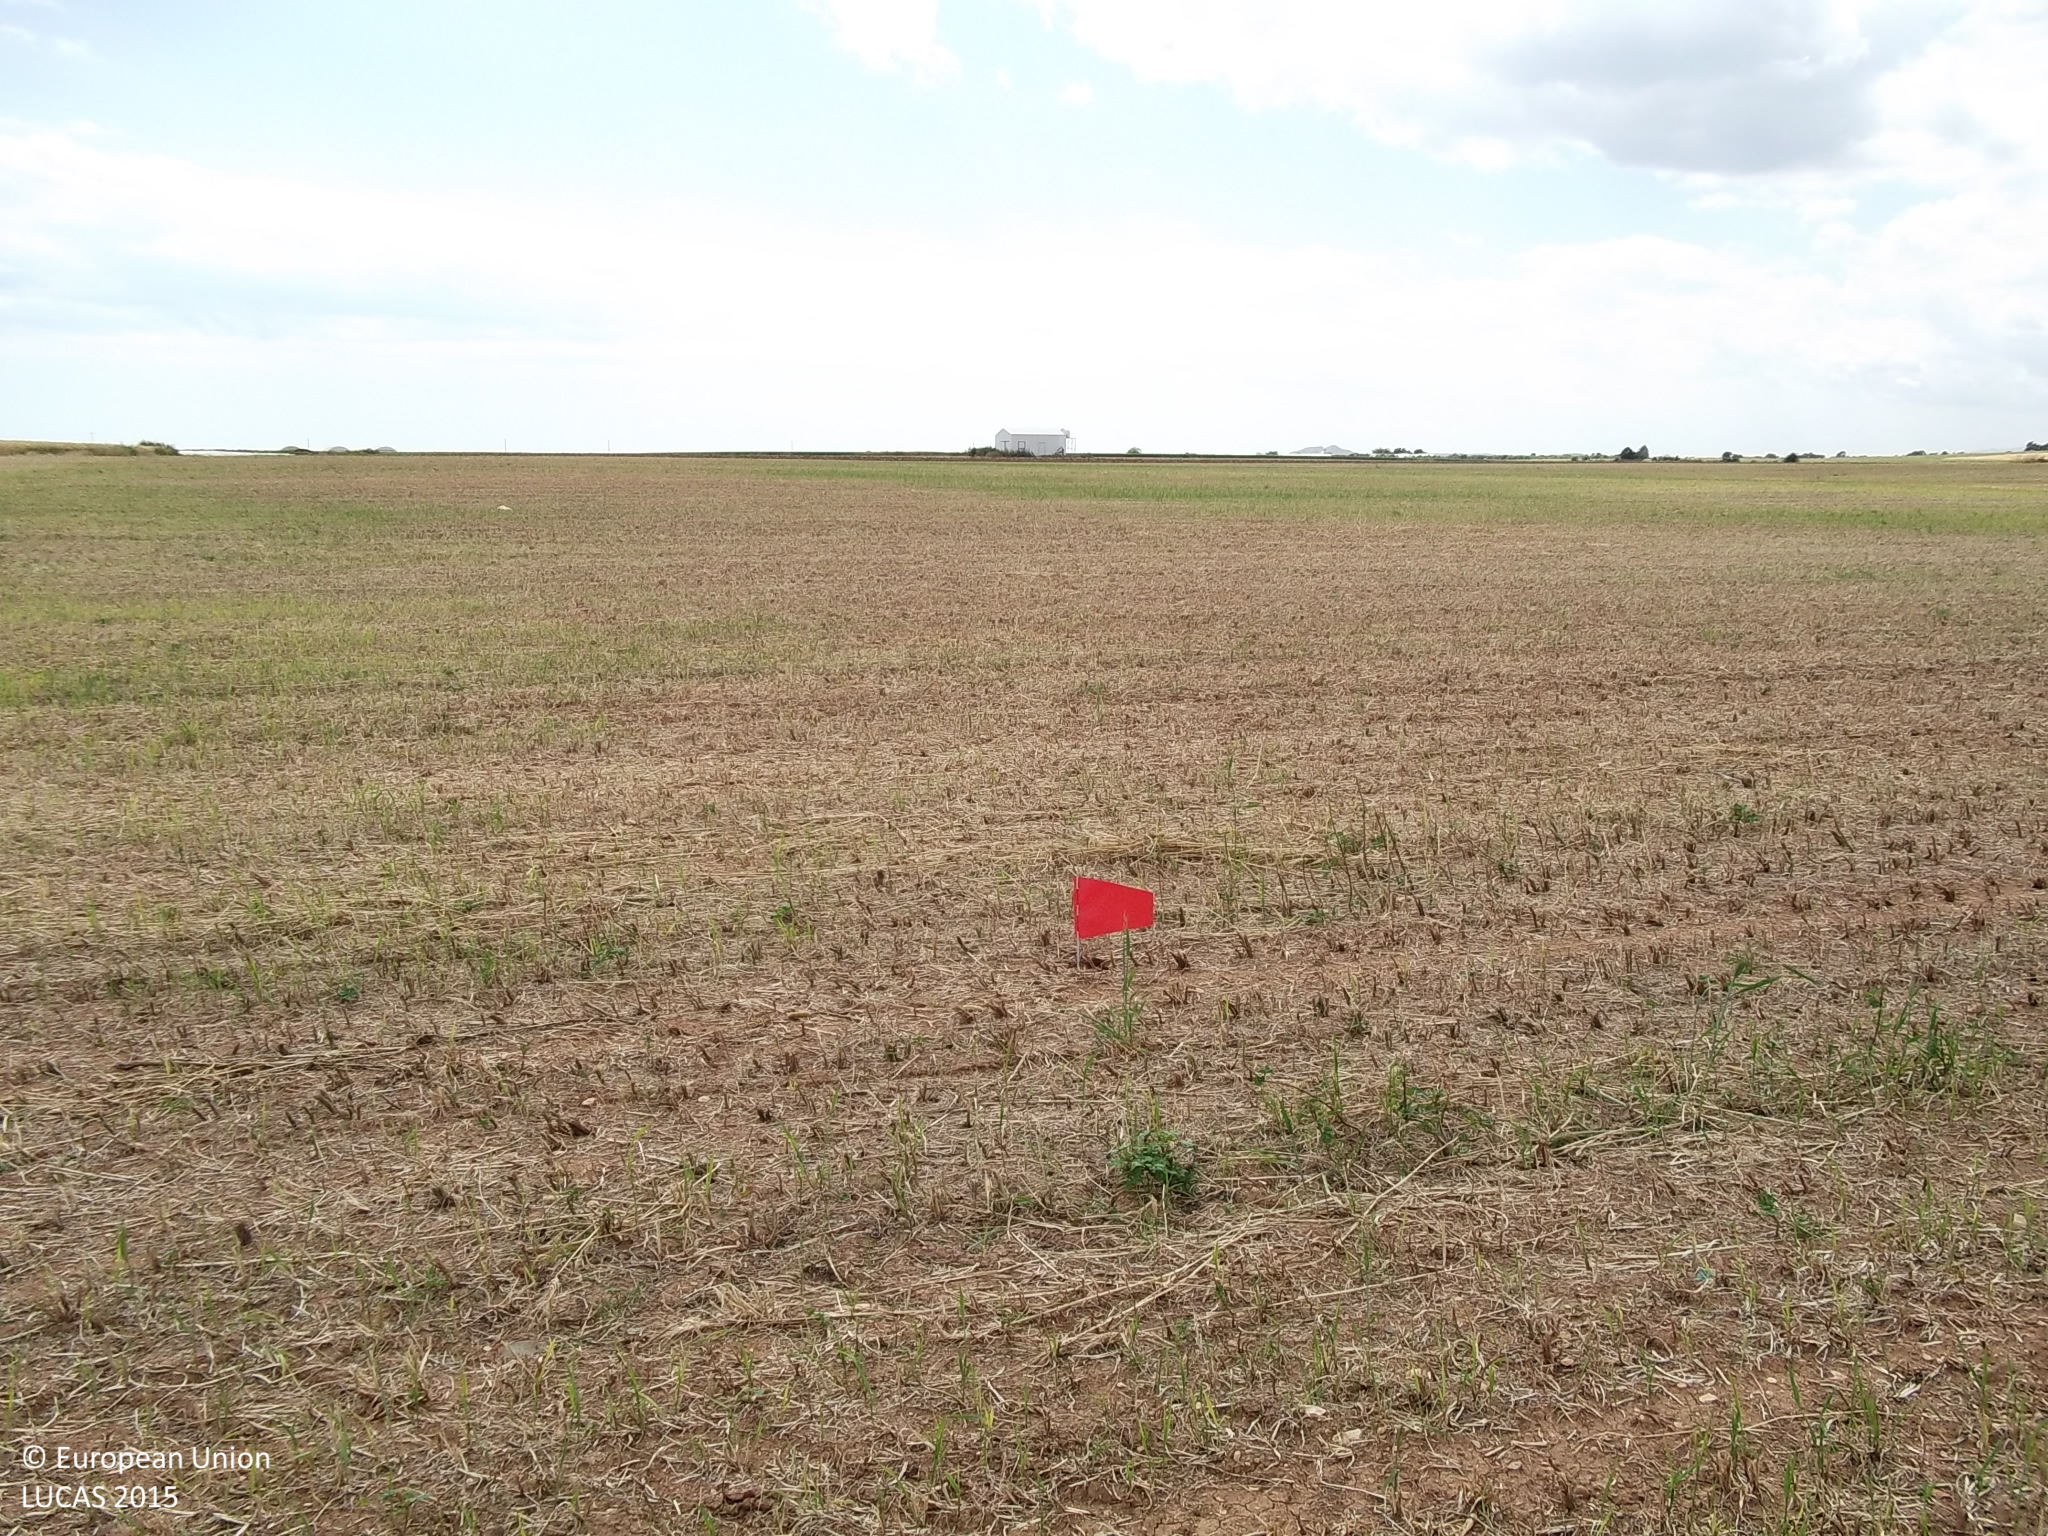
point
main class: Cropland
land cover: Common wheat
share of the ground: < 10 %
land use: Agriculture (excluding fallow land and kitchen gardens)
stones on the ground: < 10 %
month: April
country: CY
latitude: 34.8251
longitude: 33.5324
